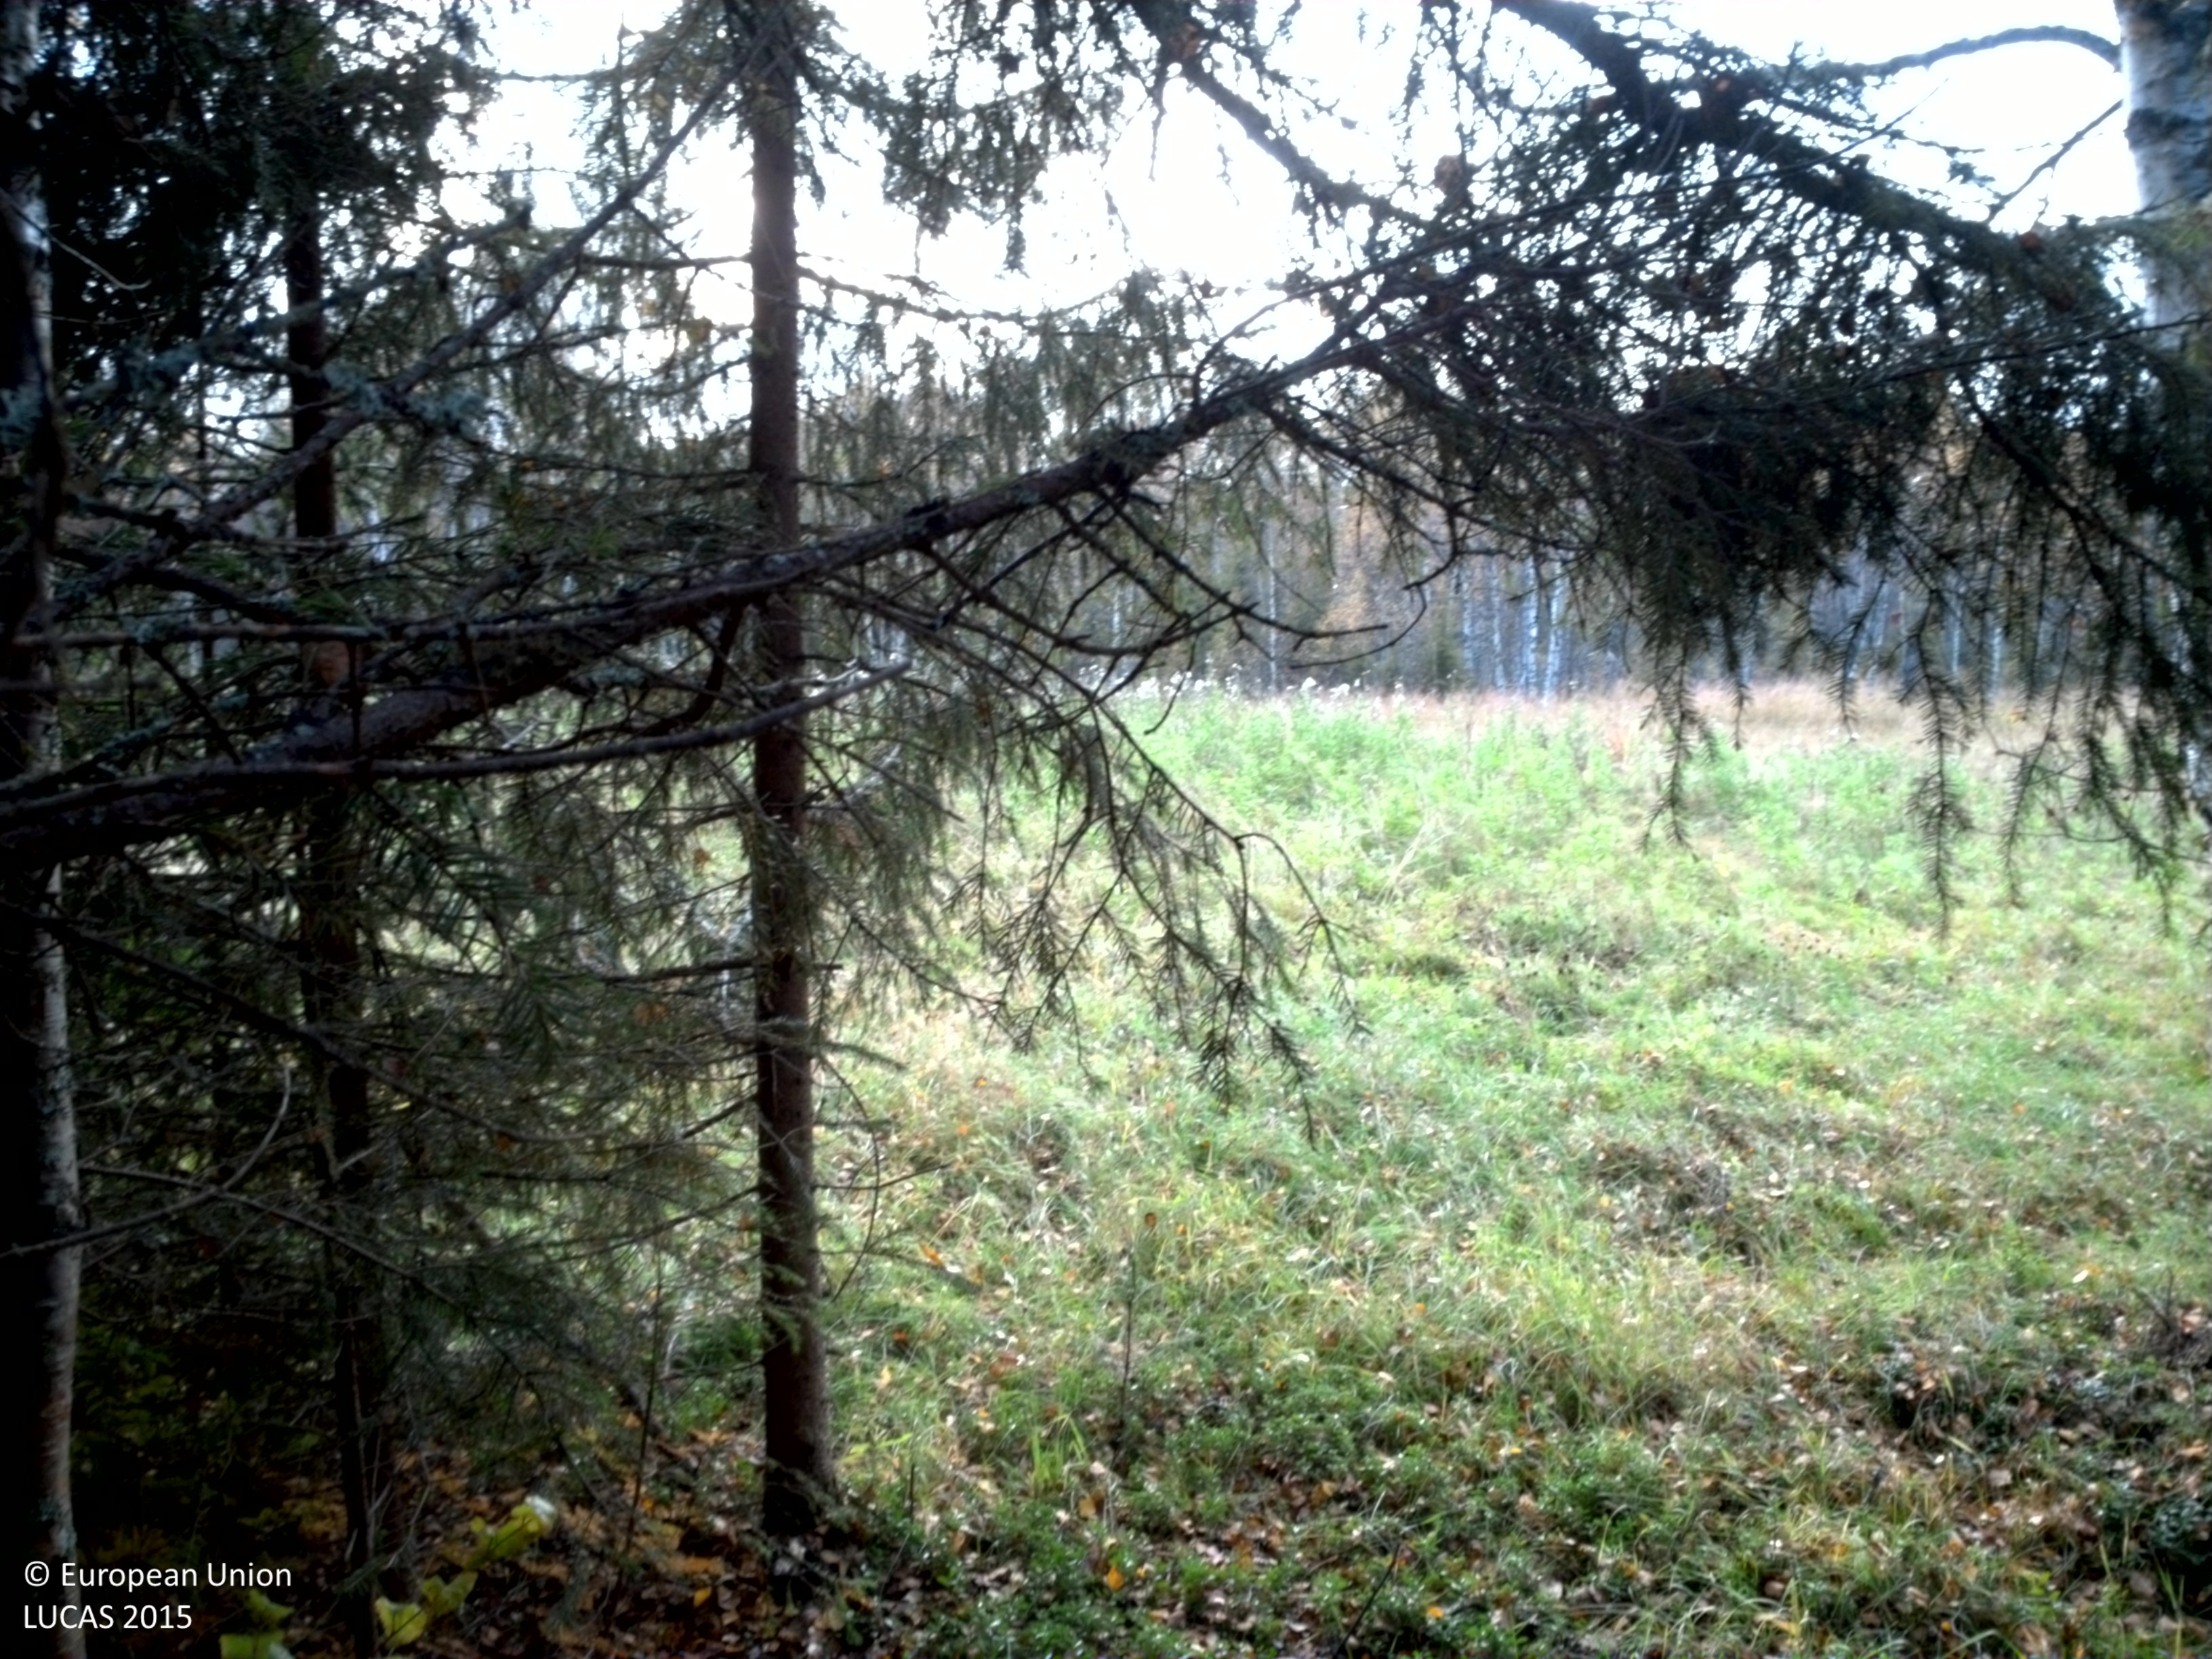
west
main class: Woodland
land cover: Spruce dominated mixed woodland
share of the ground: 50 - 75 %
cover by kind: coniferous forest trees 35 %, broadleaved forest trees 25 %, shrubs 20 %, herbaceous plants 15 %, unconsolidated bare surface 5 %
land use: Forestry
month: September
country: SE
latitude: 65.7281
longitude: 22.1210
